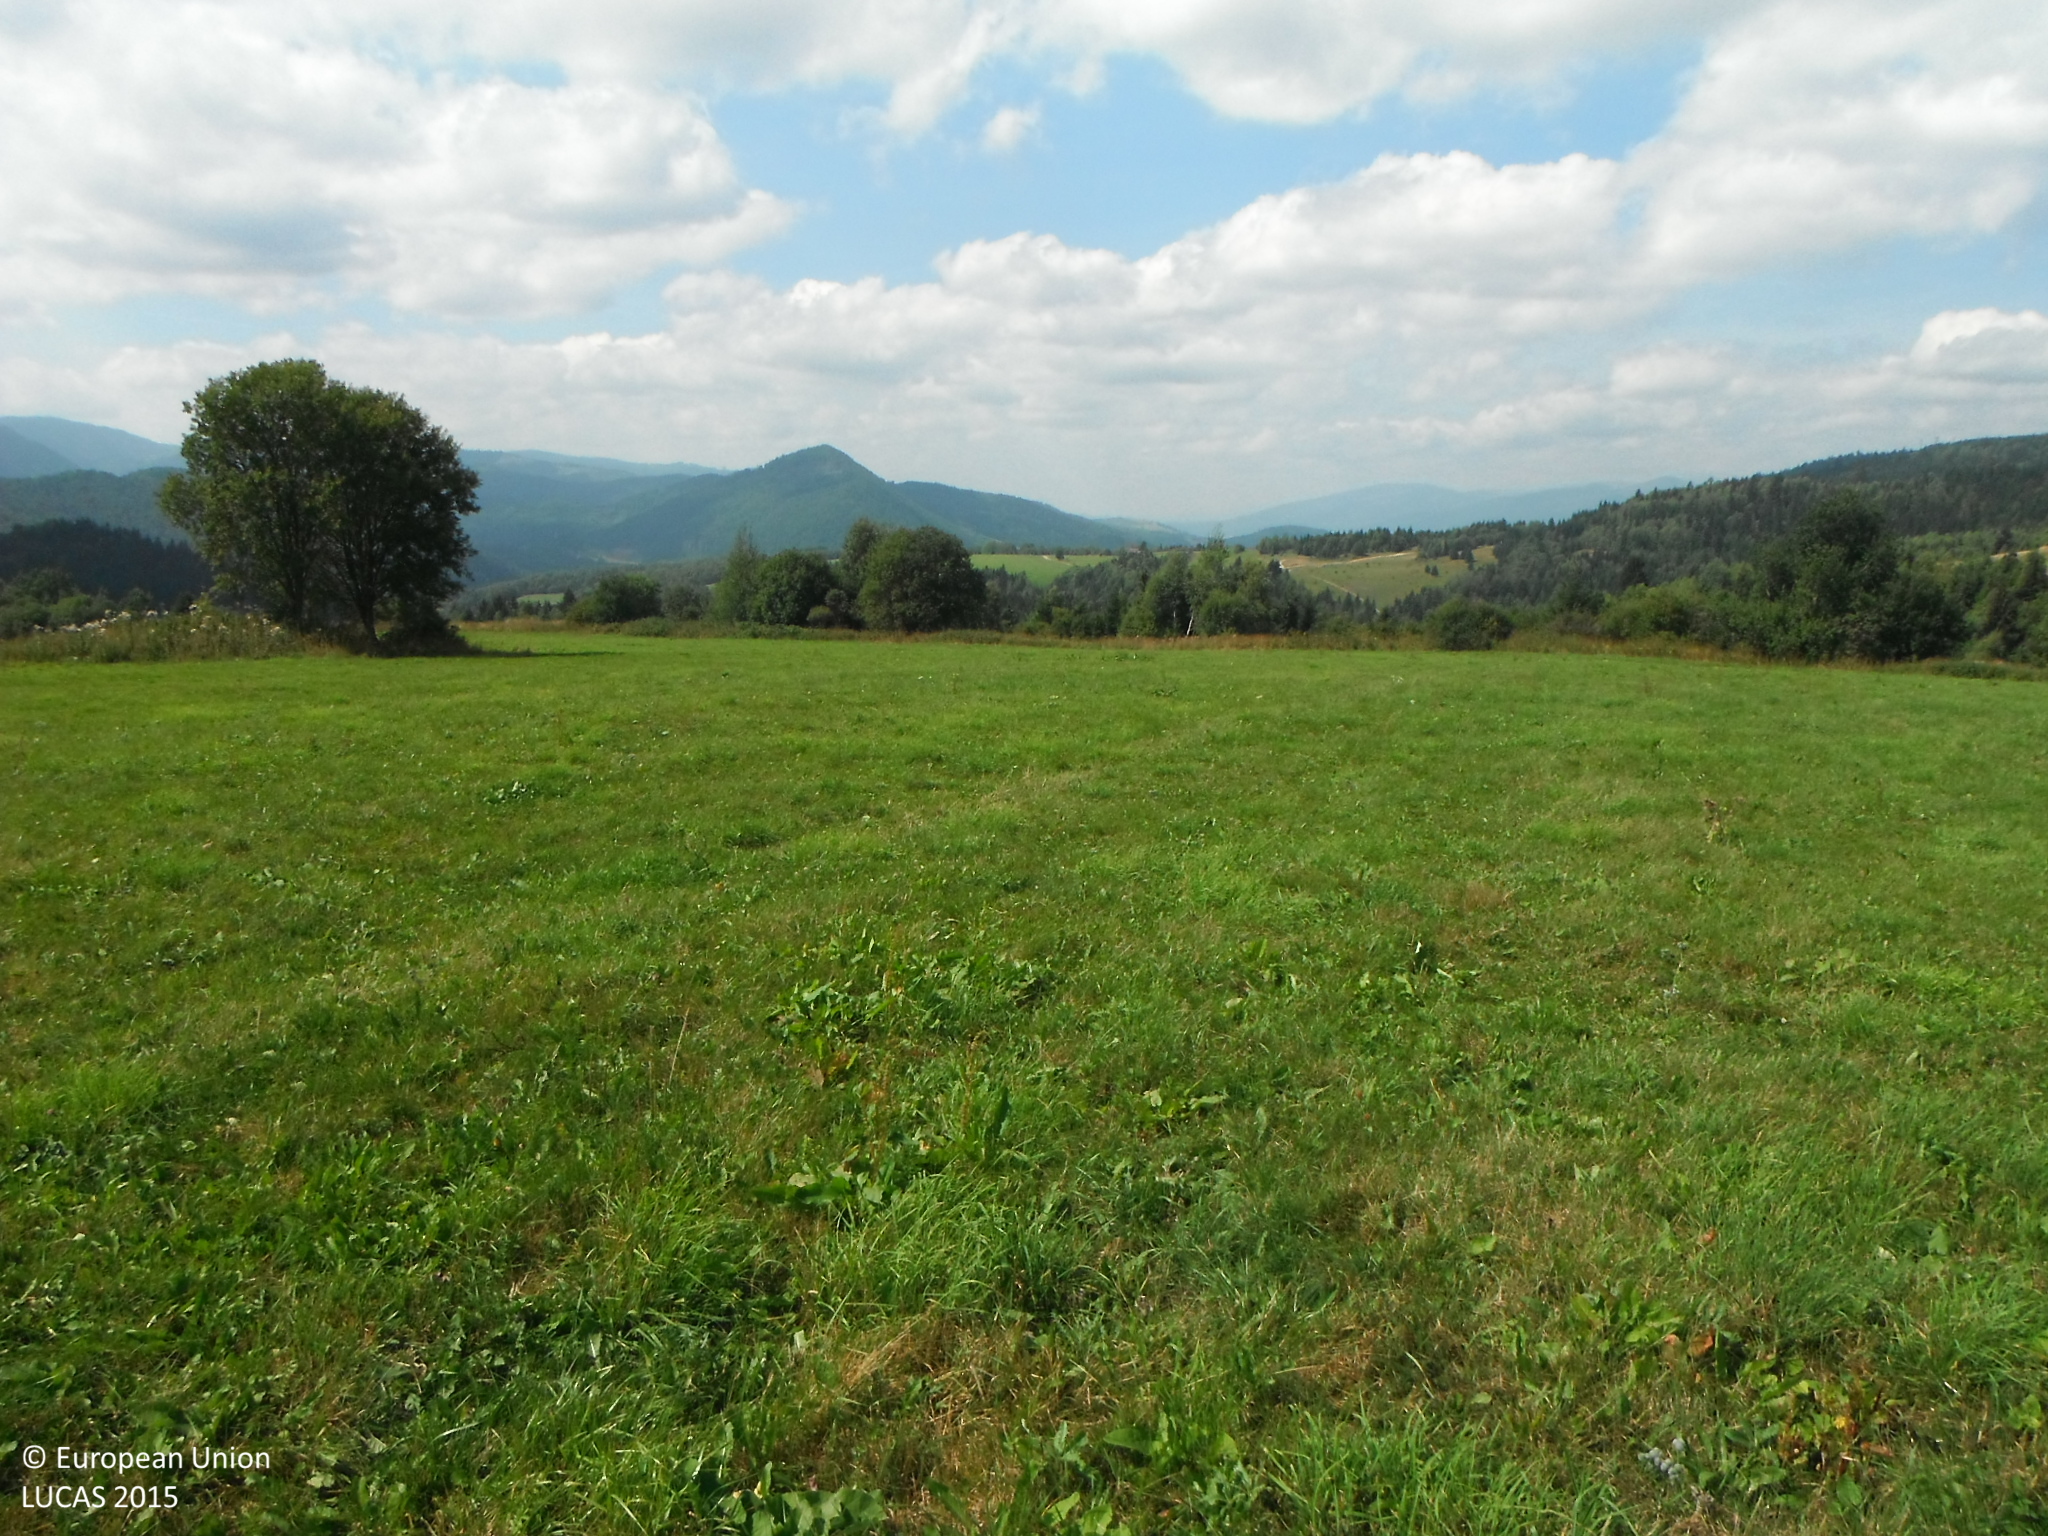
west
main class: Grassland
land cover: Grassland without tree/shrub cover
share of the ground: > 75 %
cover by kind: herbaceous plants 100 %
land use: Agriculture (excluding fallow land and kitchen gardens)
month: August
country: SK
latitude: 48.8462
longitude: 20.1017
